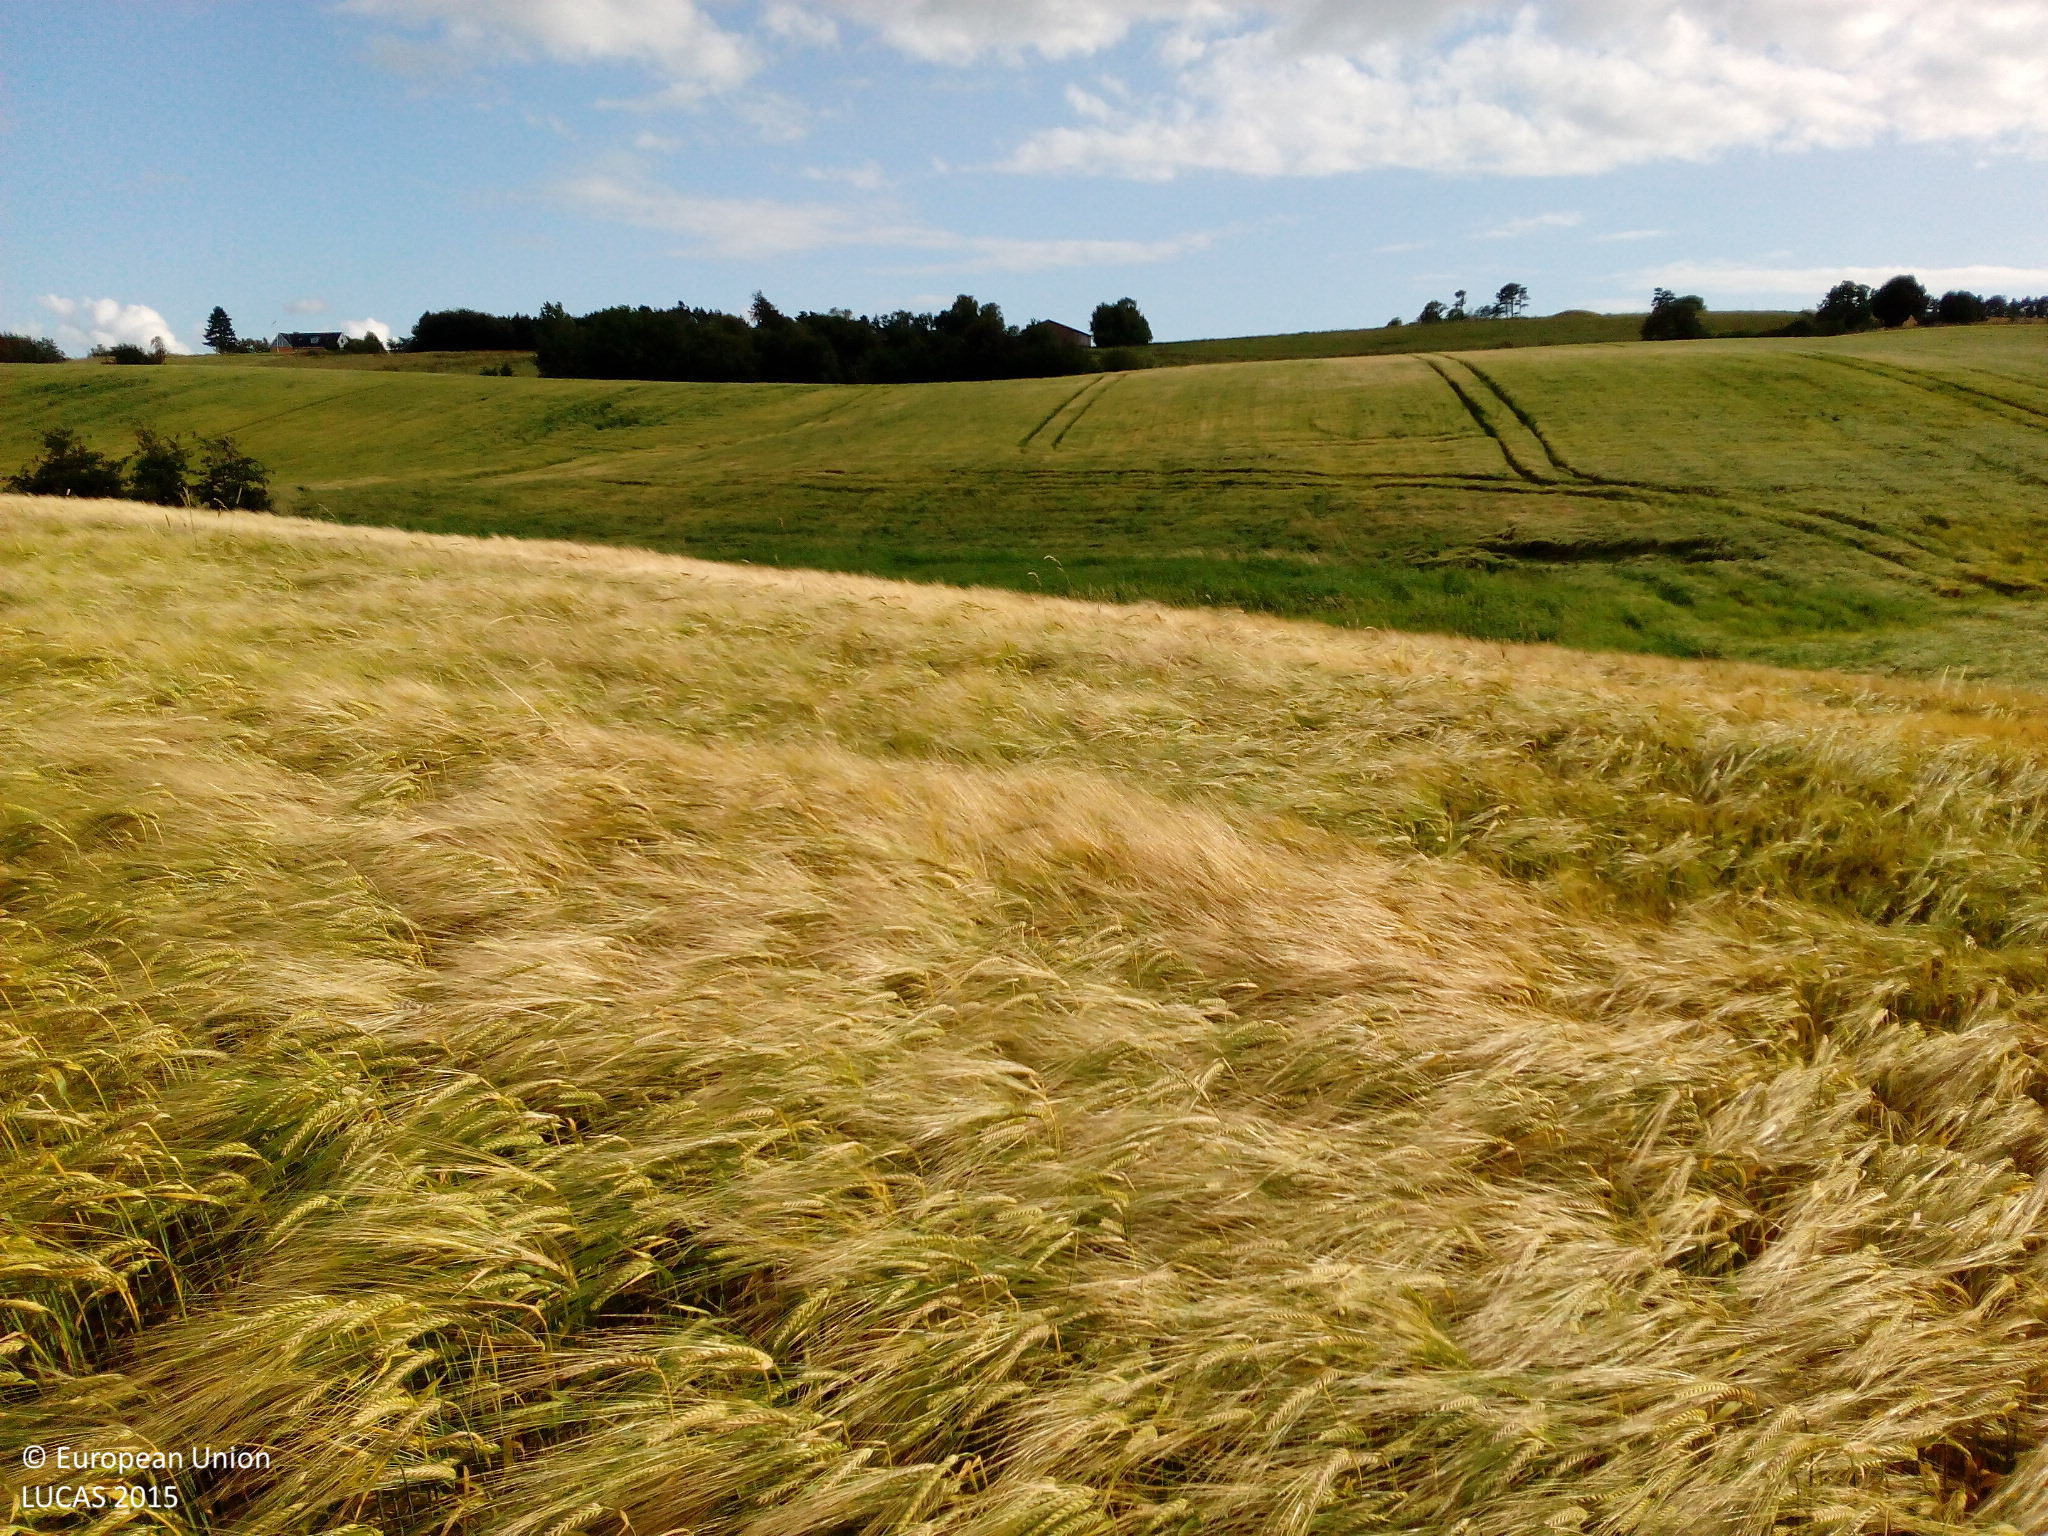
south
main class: Cropland
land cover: Barley
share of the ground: > 75 %
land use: Agriculture (excluding fallow land and kitchen gardens)
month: July
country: DK
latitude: 55.8372
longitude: 11.5154
